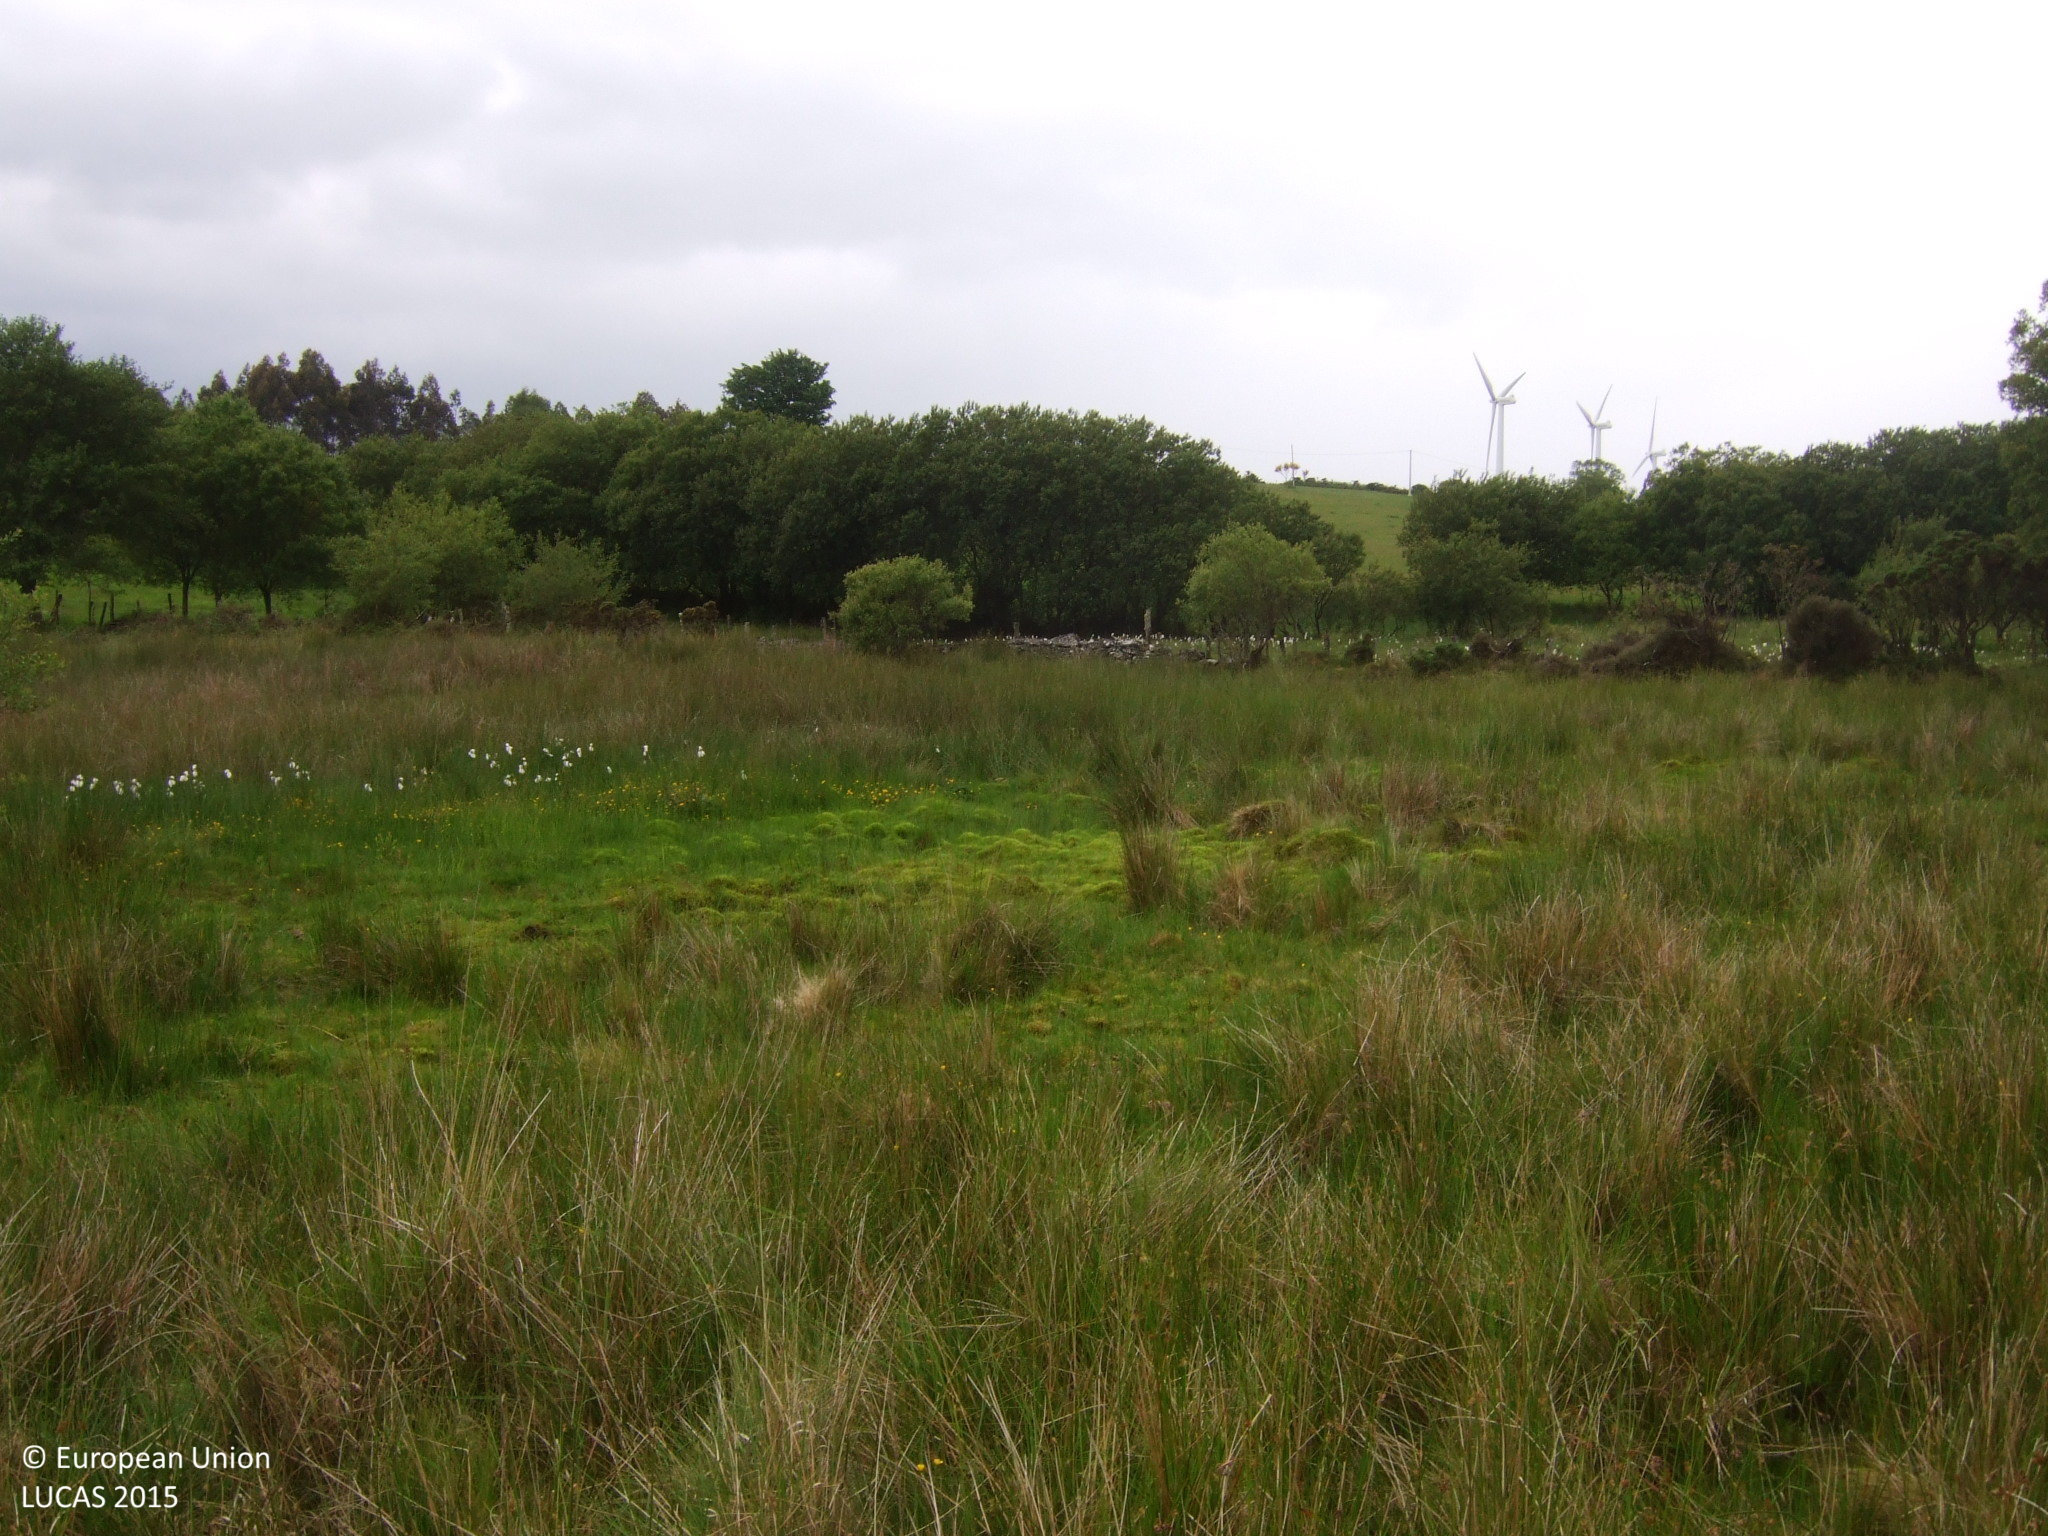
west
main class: Grassland
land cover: Grassland without tree/shrub cover
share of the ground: > 75 %
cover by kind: herbaceous plants 100 %
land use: Agriculture (excluding fallow land and kitchen gardens)
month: June
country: ES
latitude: 43.4231
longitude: -7.4839
